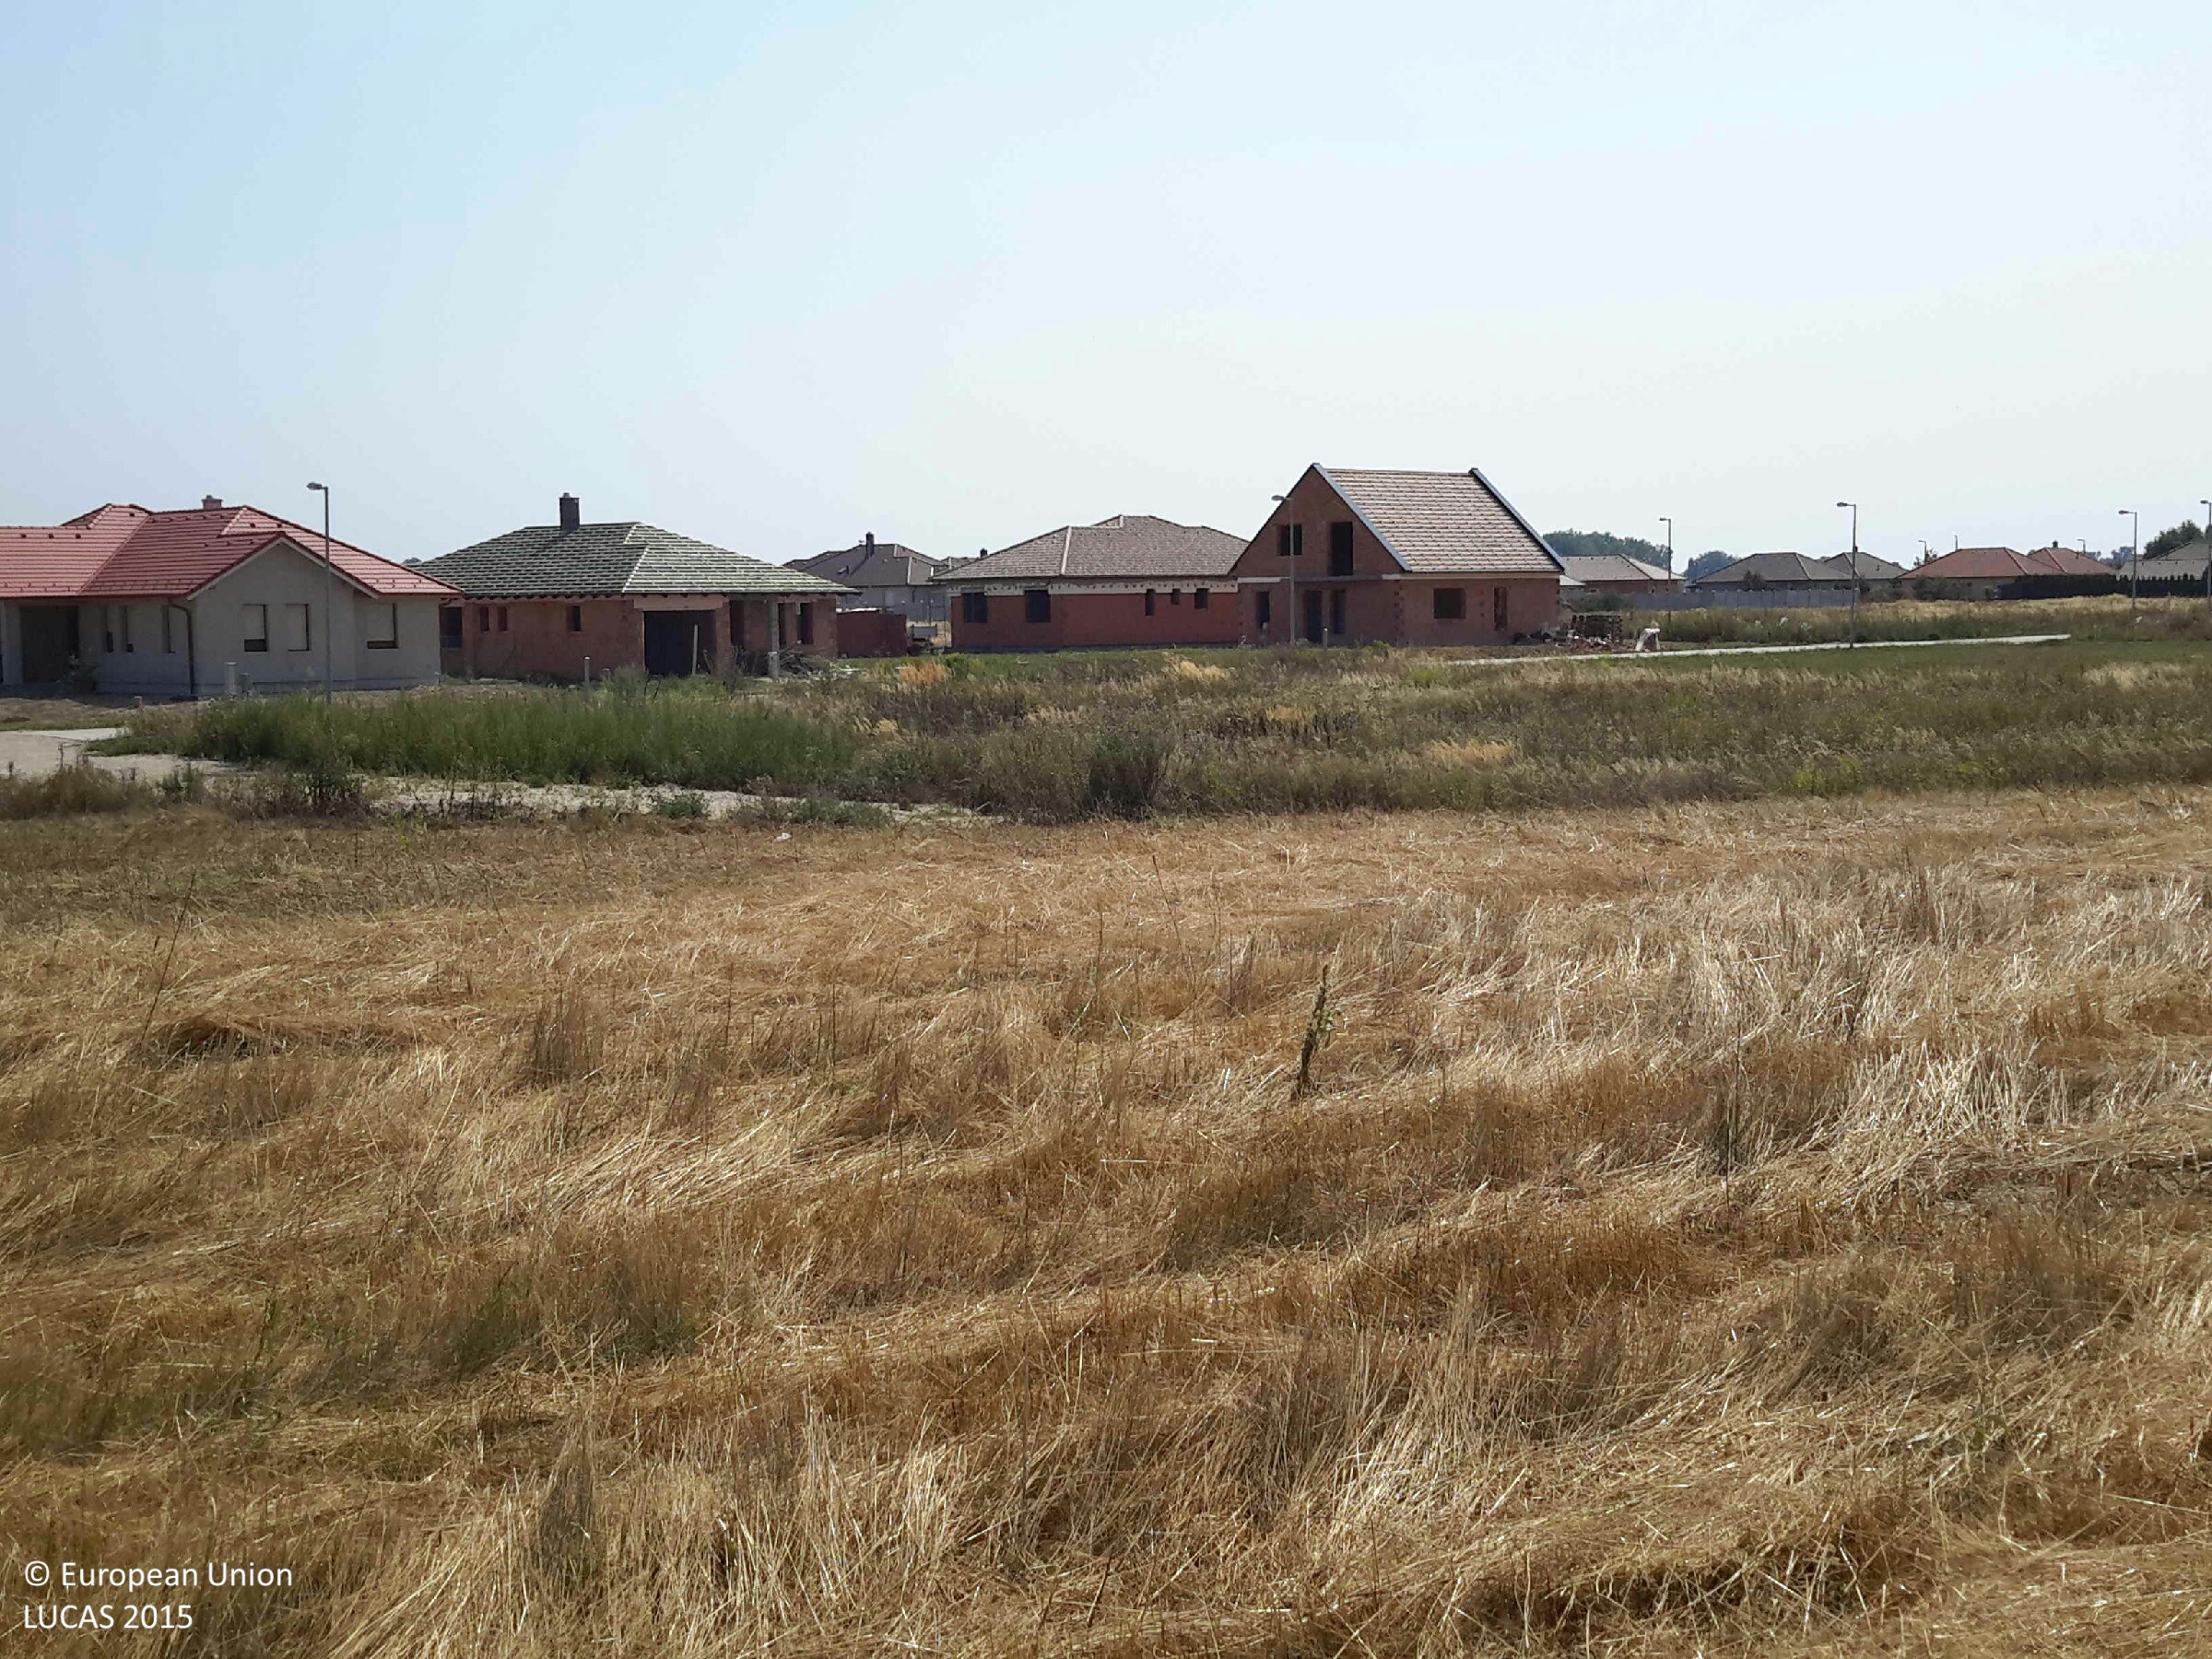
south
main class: Cropland
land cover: Temporary grasslands
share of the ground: > 75 %
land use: Agriculture (excluding fallow land and kitchen gardens)
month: August
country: HU
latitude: 47.8912
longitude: 17.2973
